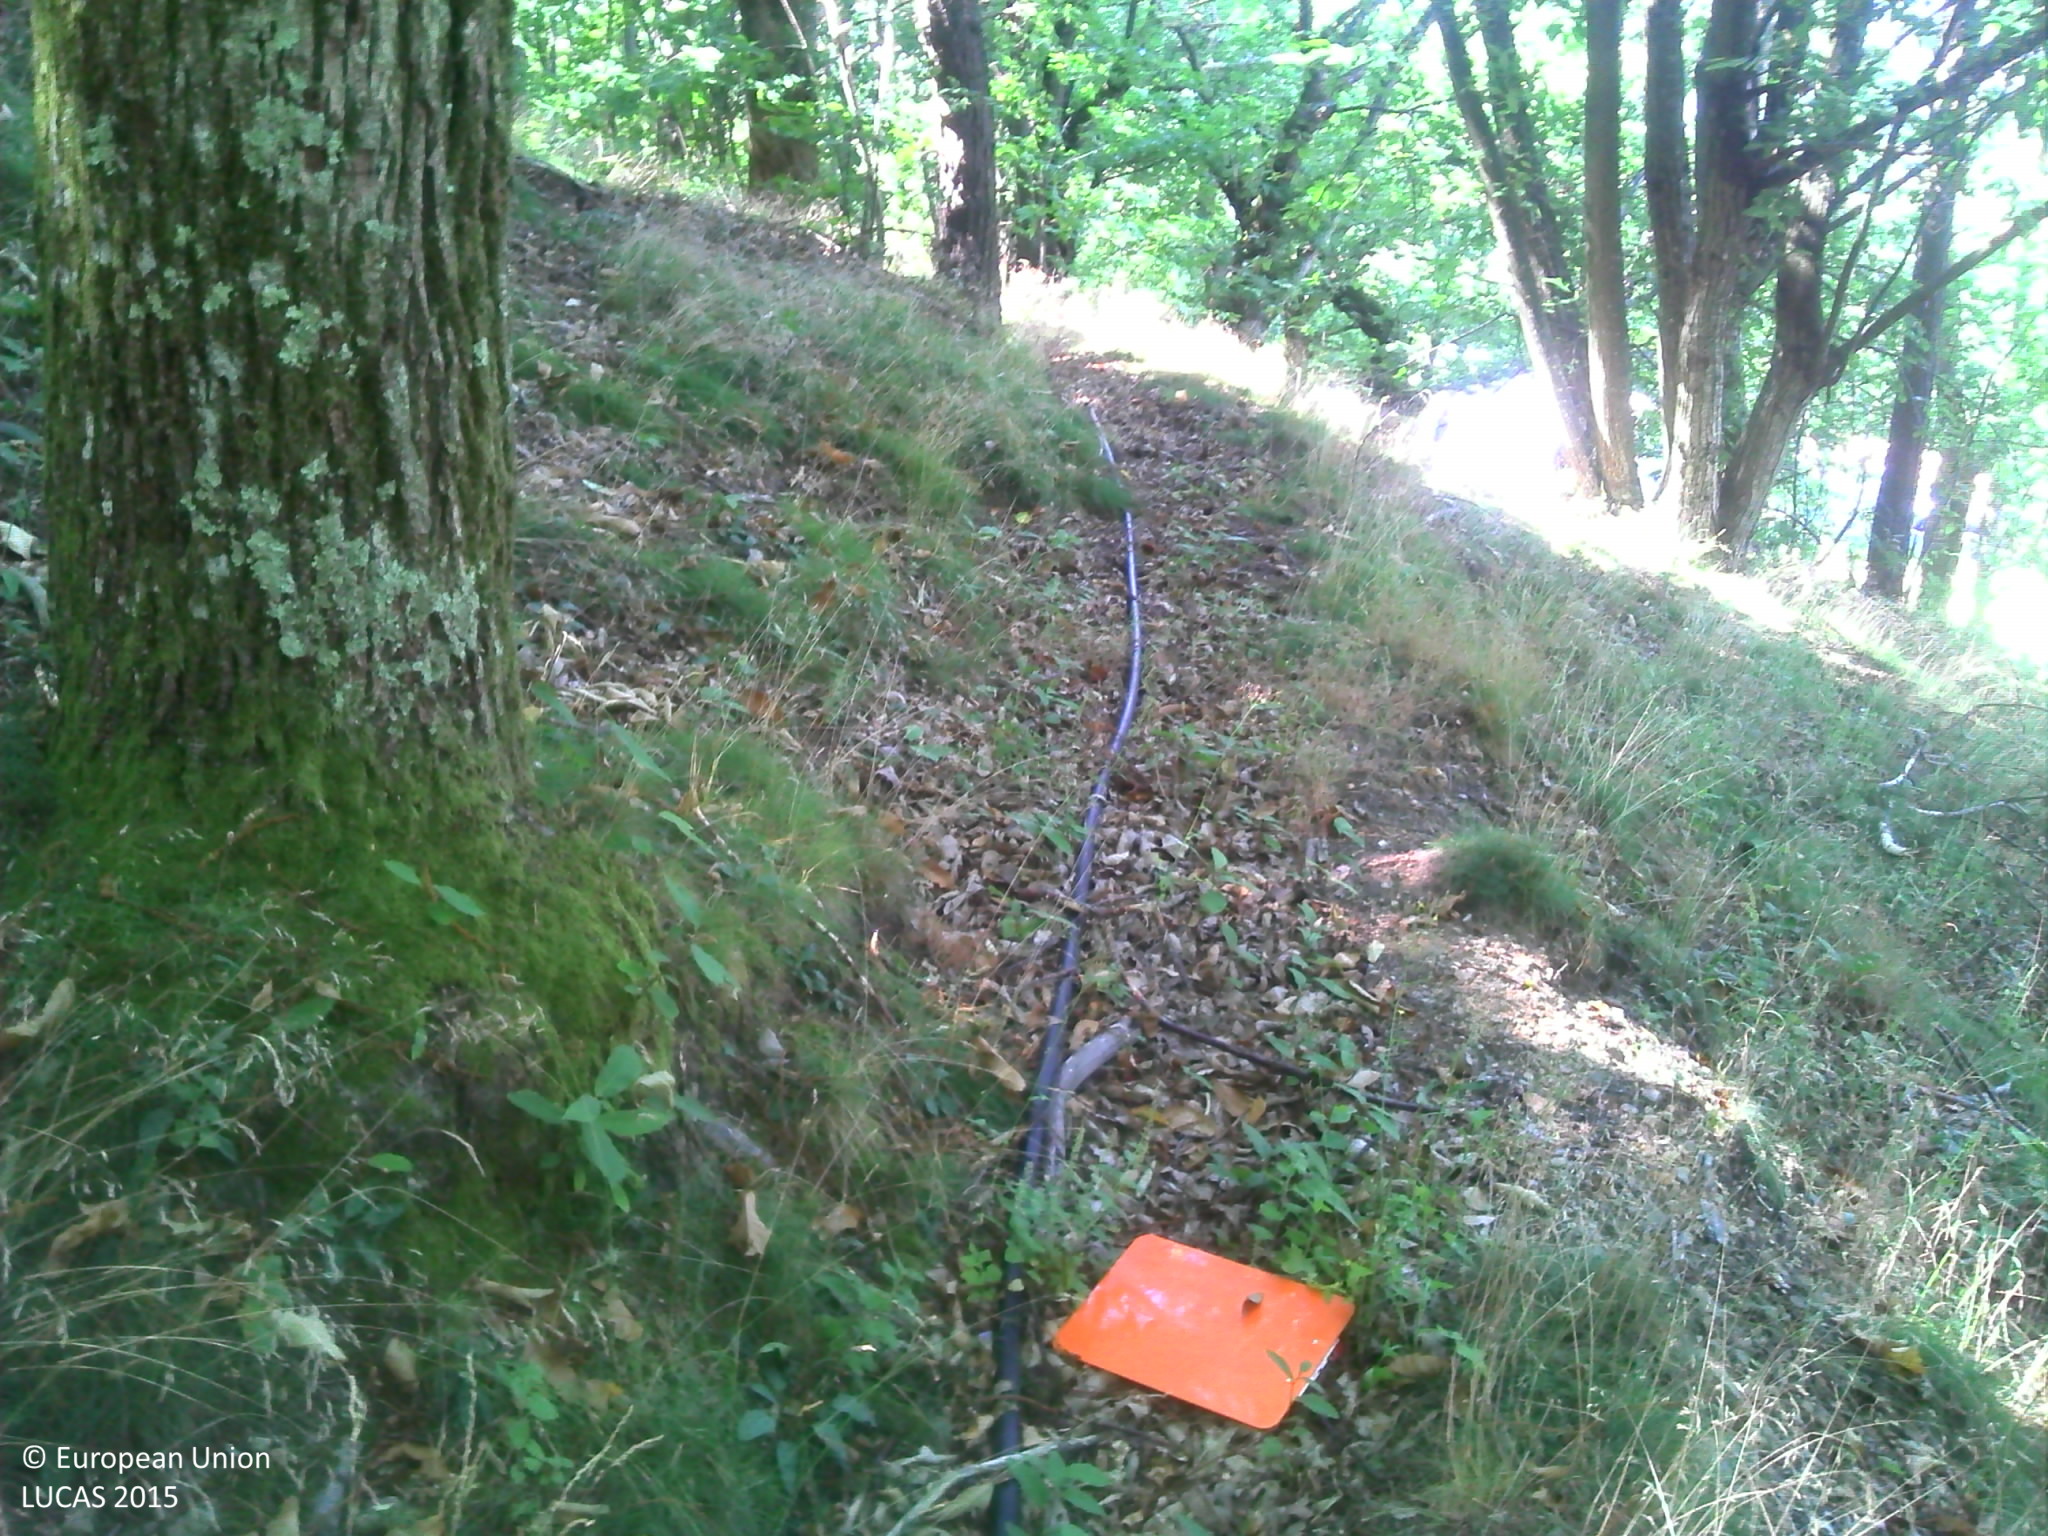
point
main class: Woodland
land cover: Broadleaved woodland
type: thermophilous deciduous forest
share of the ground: > 75 %
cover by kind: broadleaved forest trees 80 %, herbaceous plants 10 %, lichens and mosses 10 %
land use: Forestry
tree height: > 5 m
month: July
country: FR
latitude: 44.9671
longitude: 4.5662
